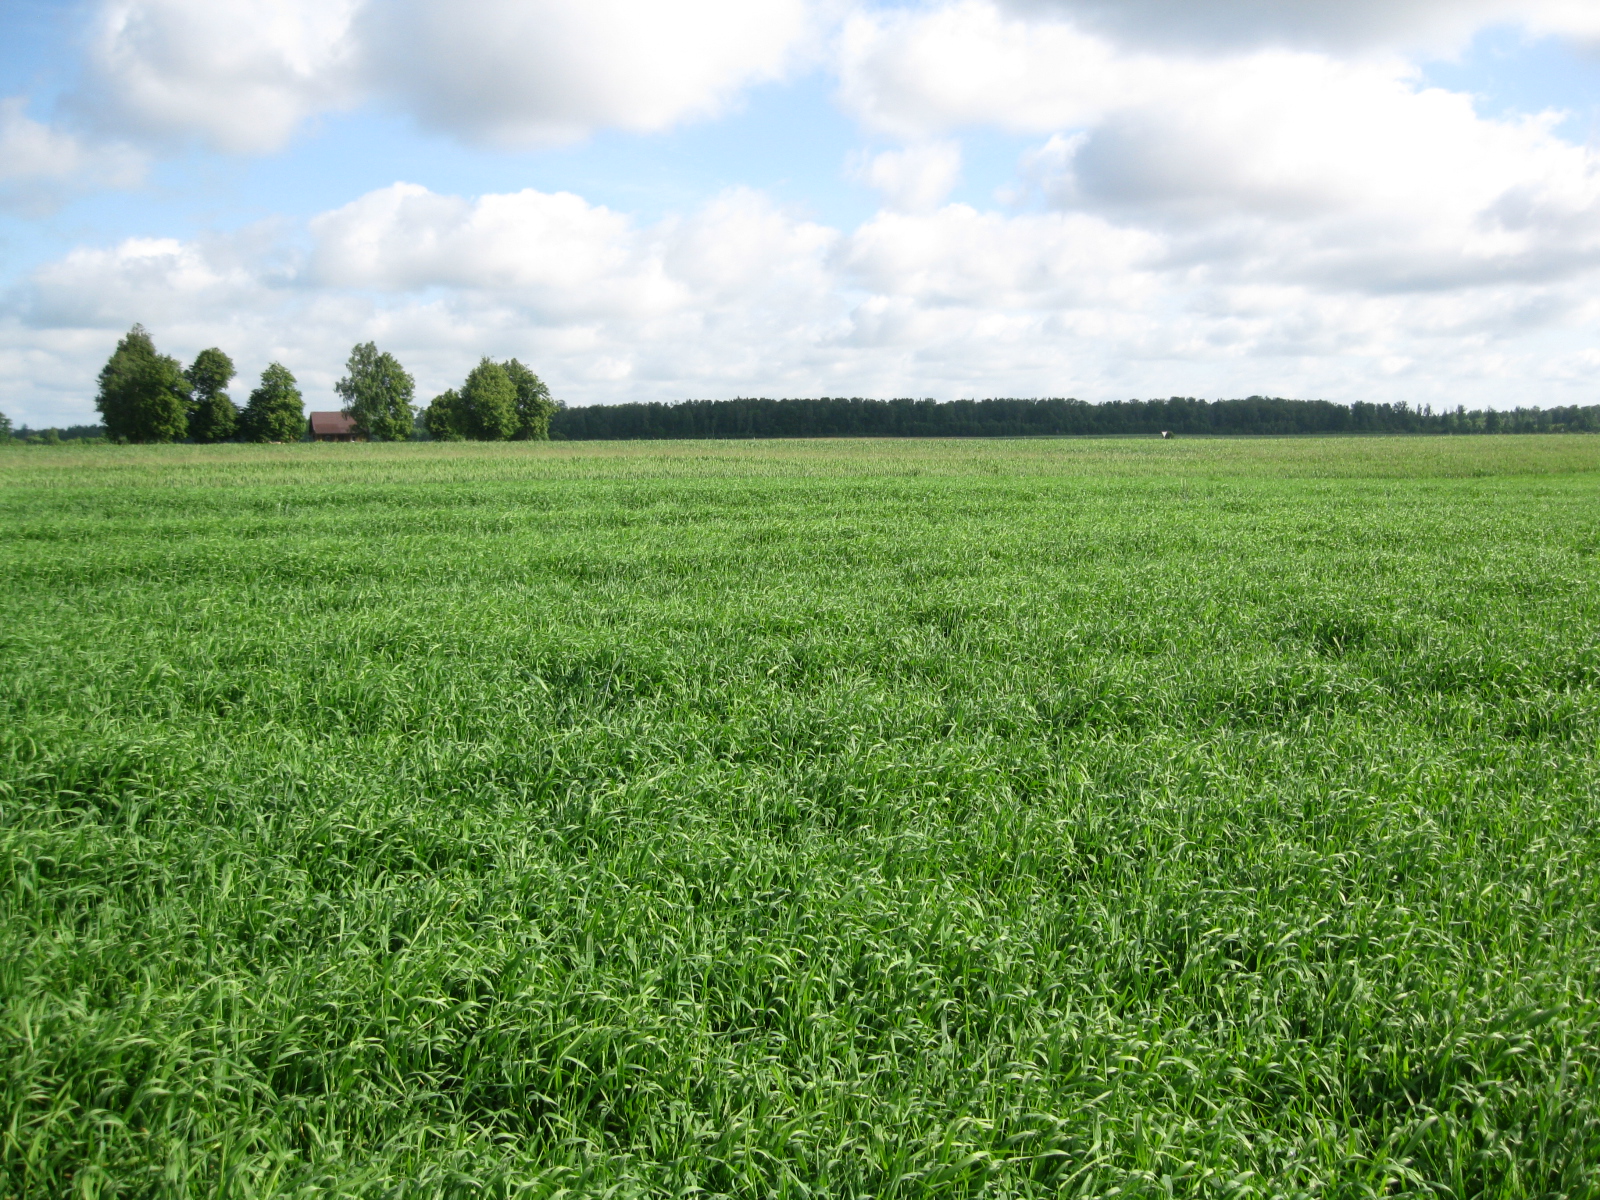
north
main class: Cropland
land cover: Barley
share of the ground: > 75 %
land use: Agriculture (excluding fallow land and kitchen gardens)
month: June
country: LT
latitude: 55.1921
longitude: 23.7031
